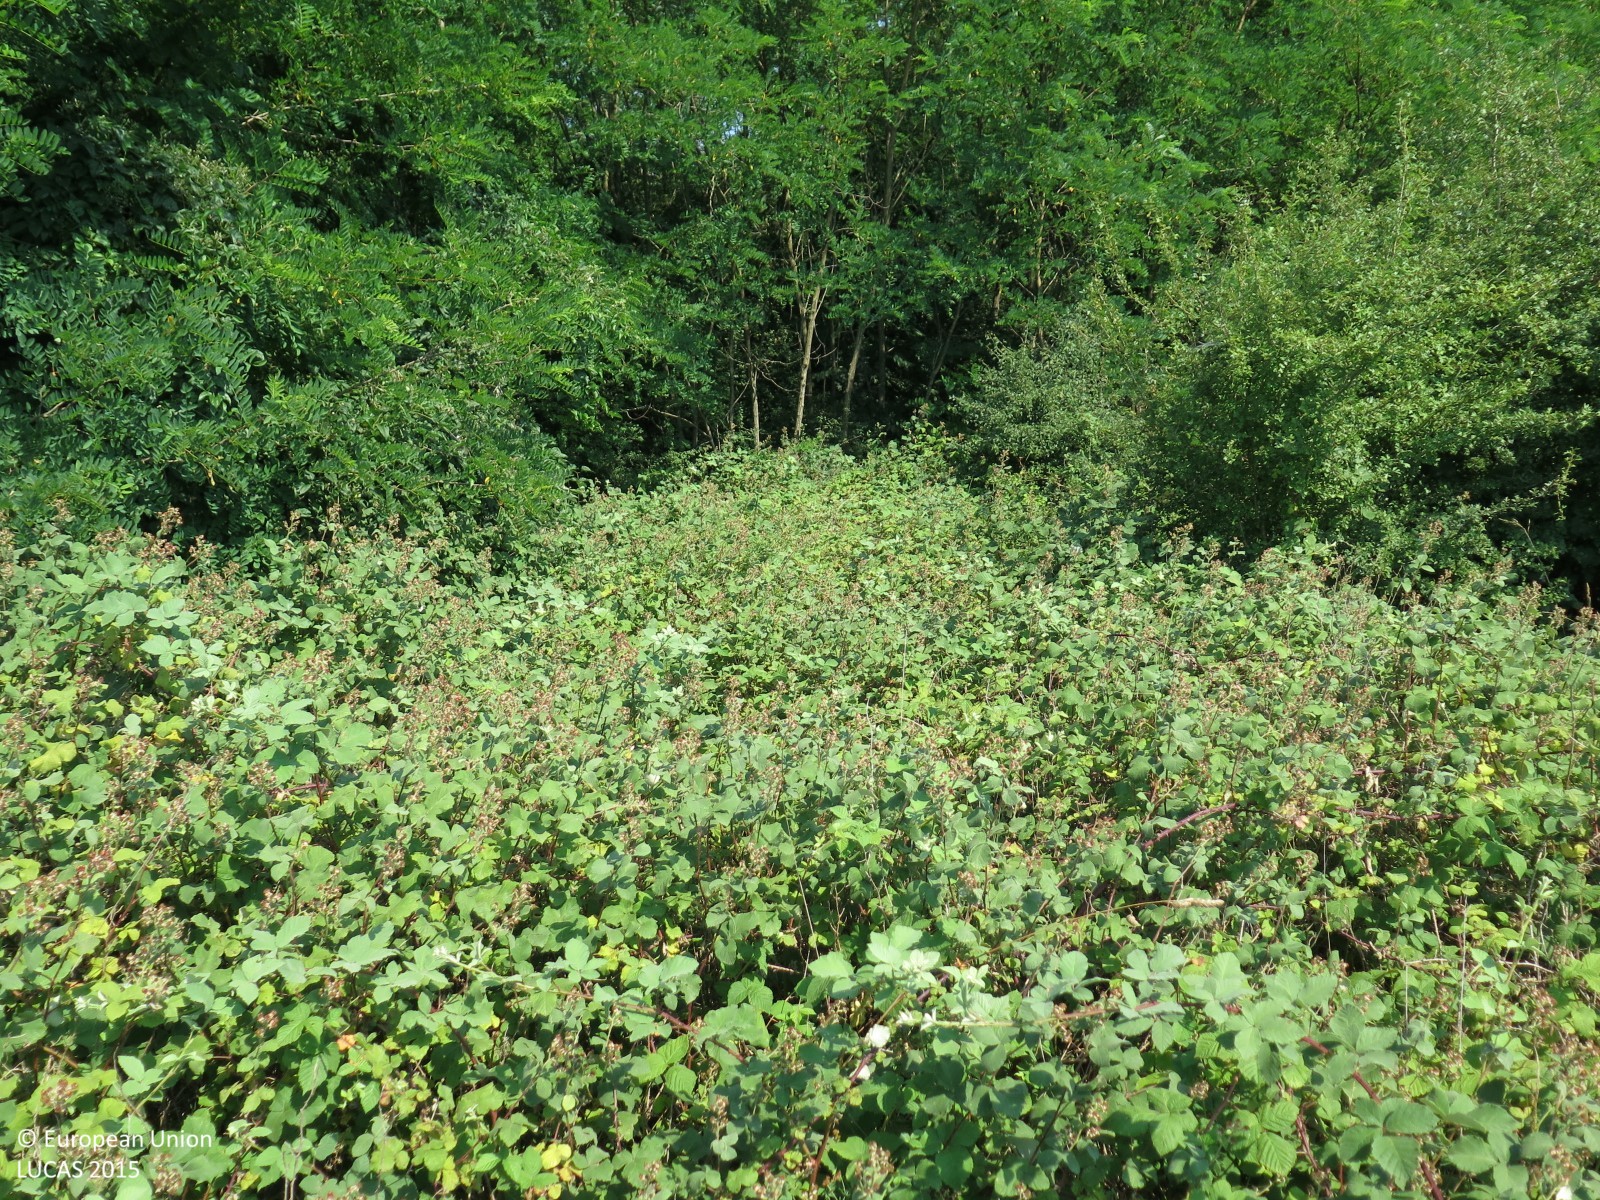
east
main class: Shrubland
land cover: Shrubland with sparse tree cover
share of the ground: > 75 %
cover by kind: shrubs 90 %, broadleaved forest trees 5 %, herbaceous plants 5 %
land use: Semi-natural and natural areas not in use
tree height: > 5 m
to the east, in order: Shrubland with sparse tree cover; Broadleaved woodland; Grass margins; Broadleaved woodland
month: July
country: HR
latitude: 45.4820
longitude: 13.5136
